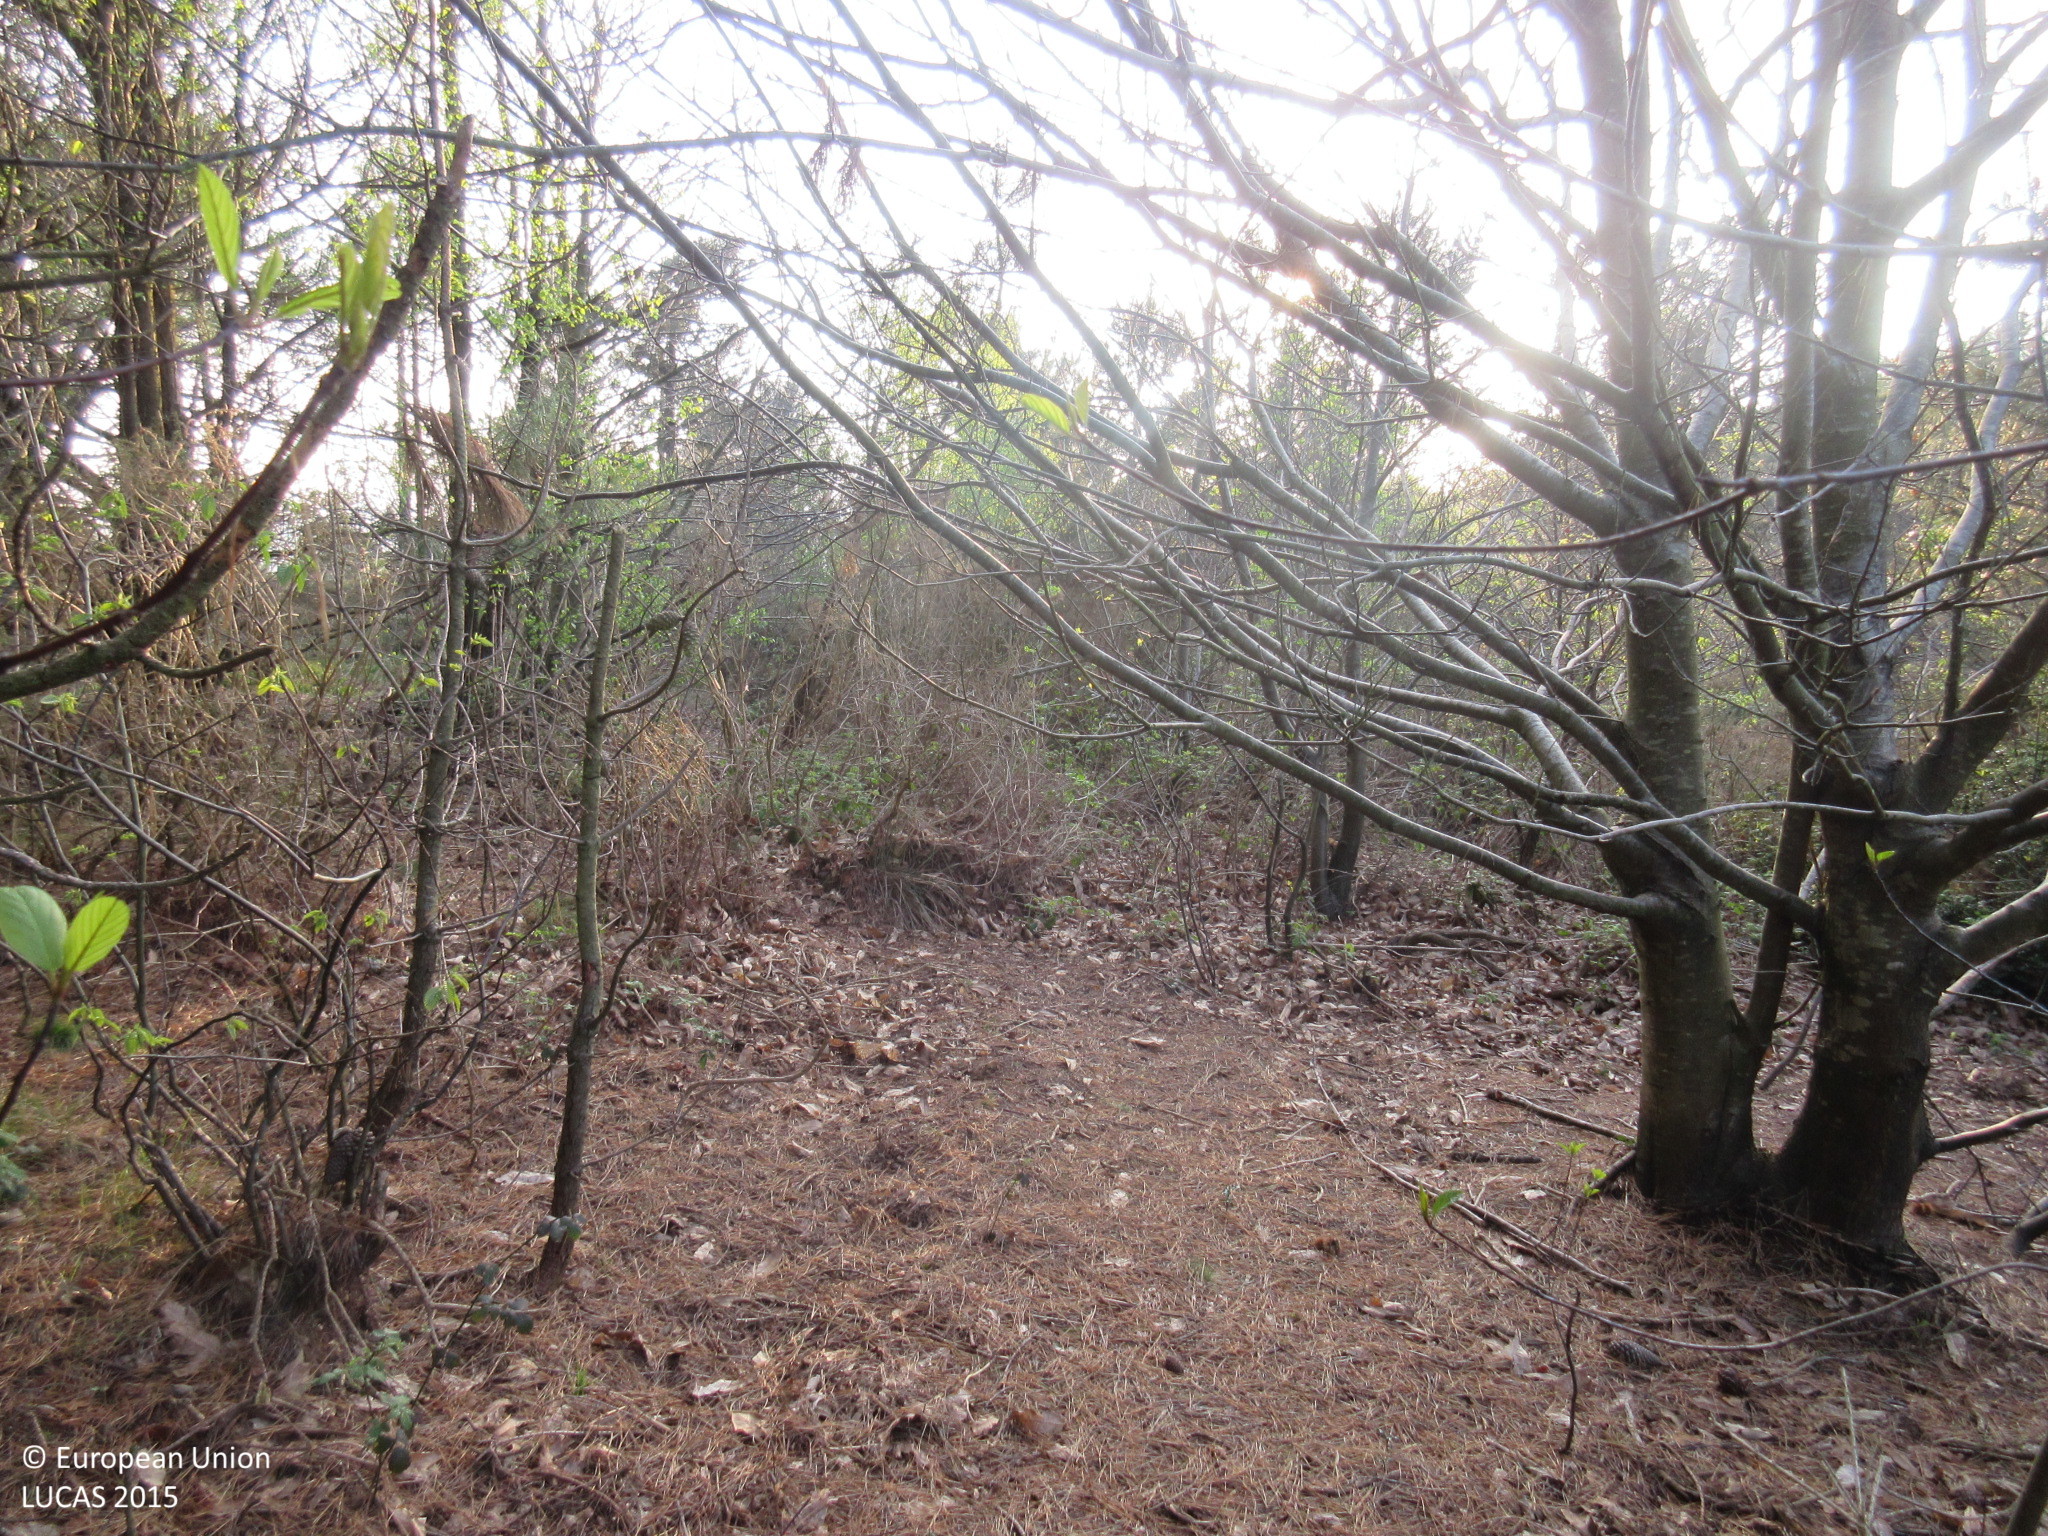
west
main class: Woodland
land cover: Pine dominated mixed woodland
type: hemiboreal forest and nemoral coniferous forest and mixed broadleaved-coniferous forest
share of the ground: 50 - 75 %
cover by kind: coniferous forest trees 50 %, shrubs 30 %, broadleaved forest trees 20 %
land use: Forestry
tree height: > 5 m
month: April
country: ES
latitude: 43.3761
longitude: -6.7847
